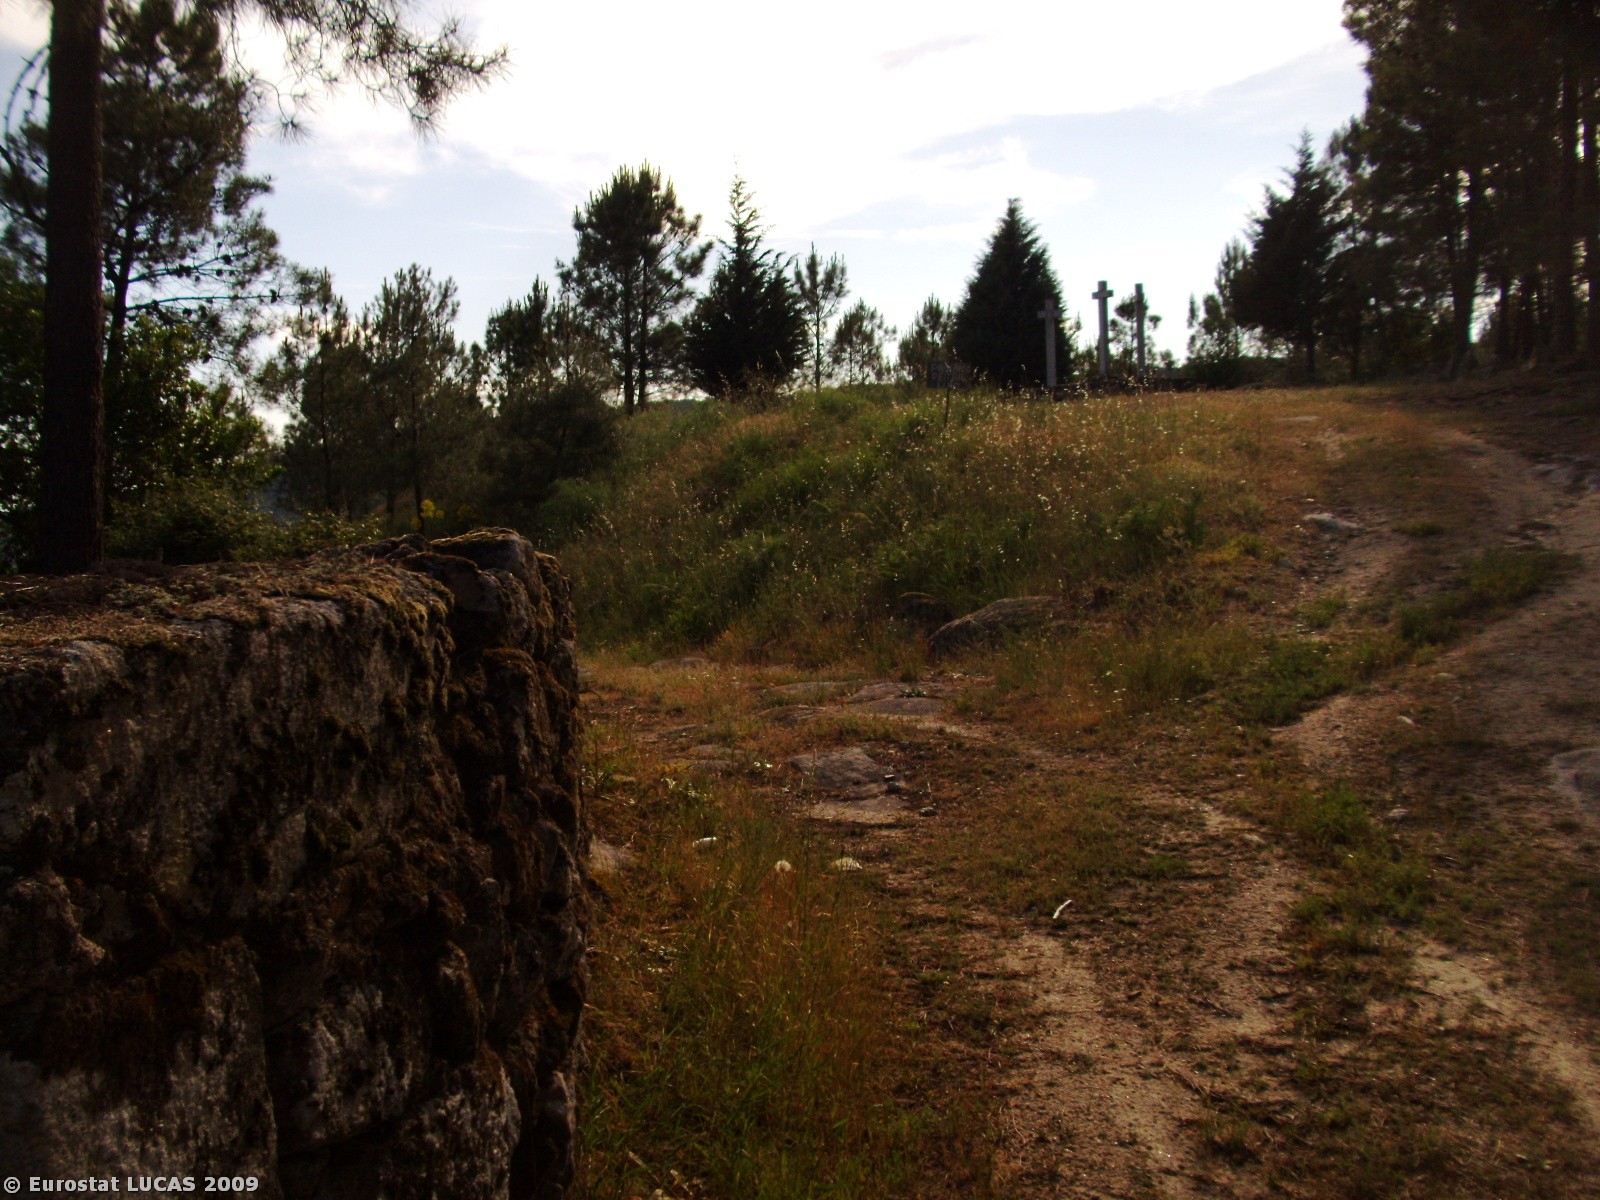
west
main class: Grassland
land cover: Spontaneously vegetated surfaces
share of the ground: > 75 %
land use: Fallow land
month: May
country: PT
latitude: 40.6575
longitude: -7.4879
